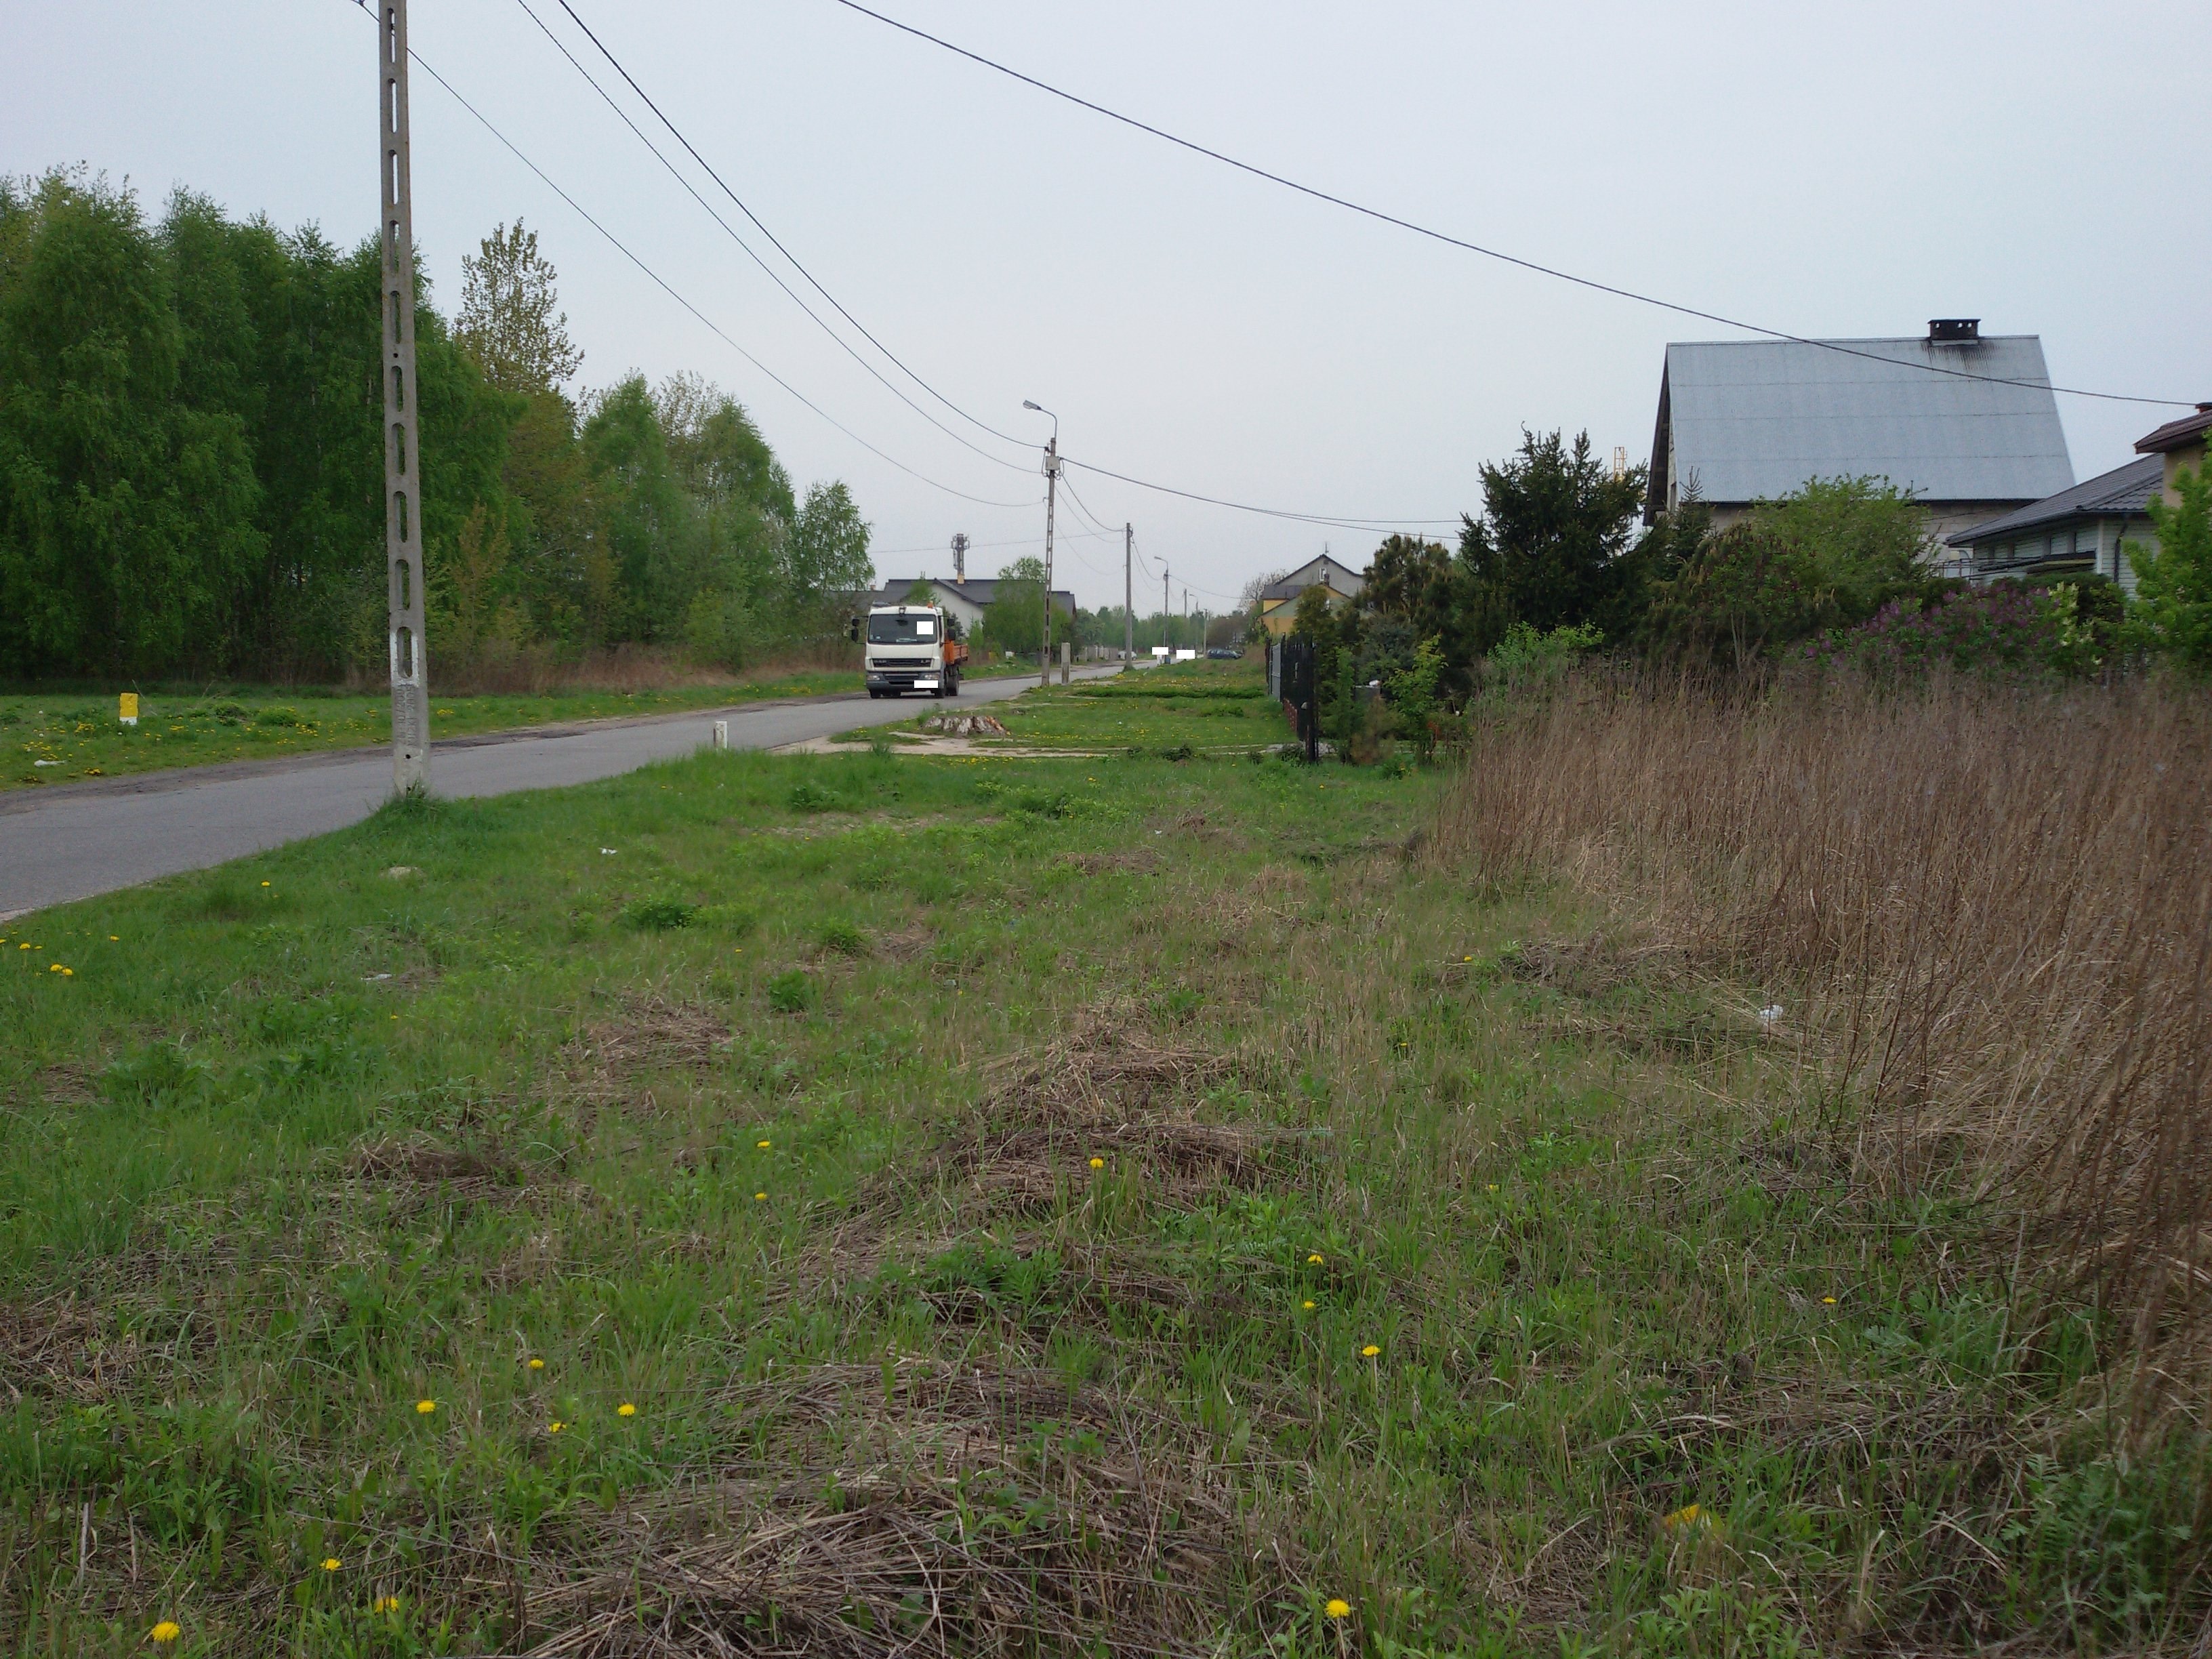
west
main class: Grassland
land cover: Spontaneously vegetated surfaces
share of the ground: > 75 %
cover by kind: herbaceous plants 100 %
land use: Fallow land
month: May
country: PL
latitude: 52.0454
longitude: 23.1271
